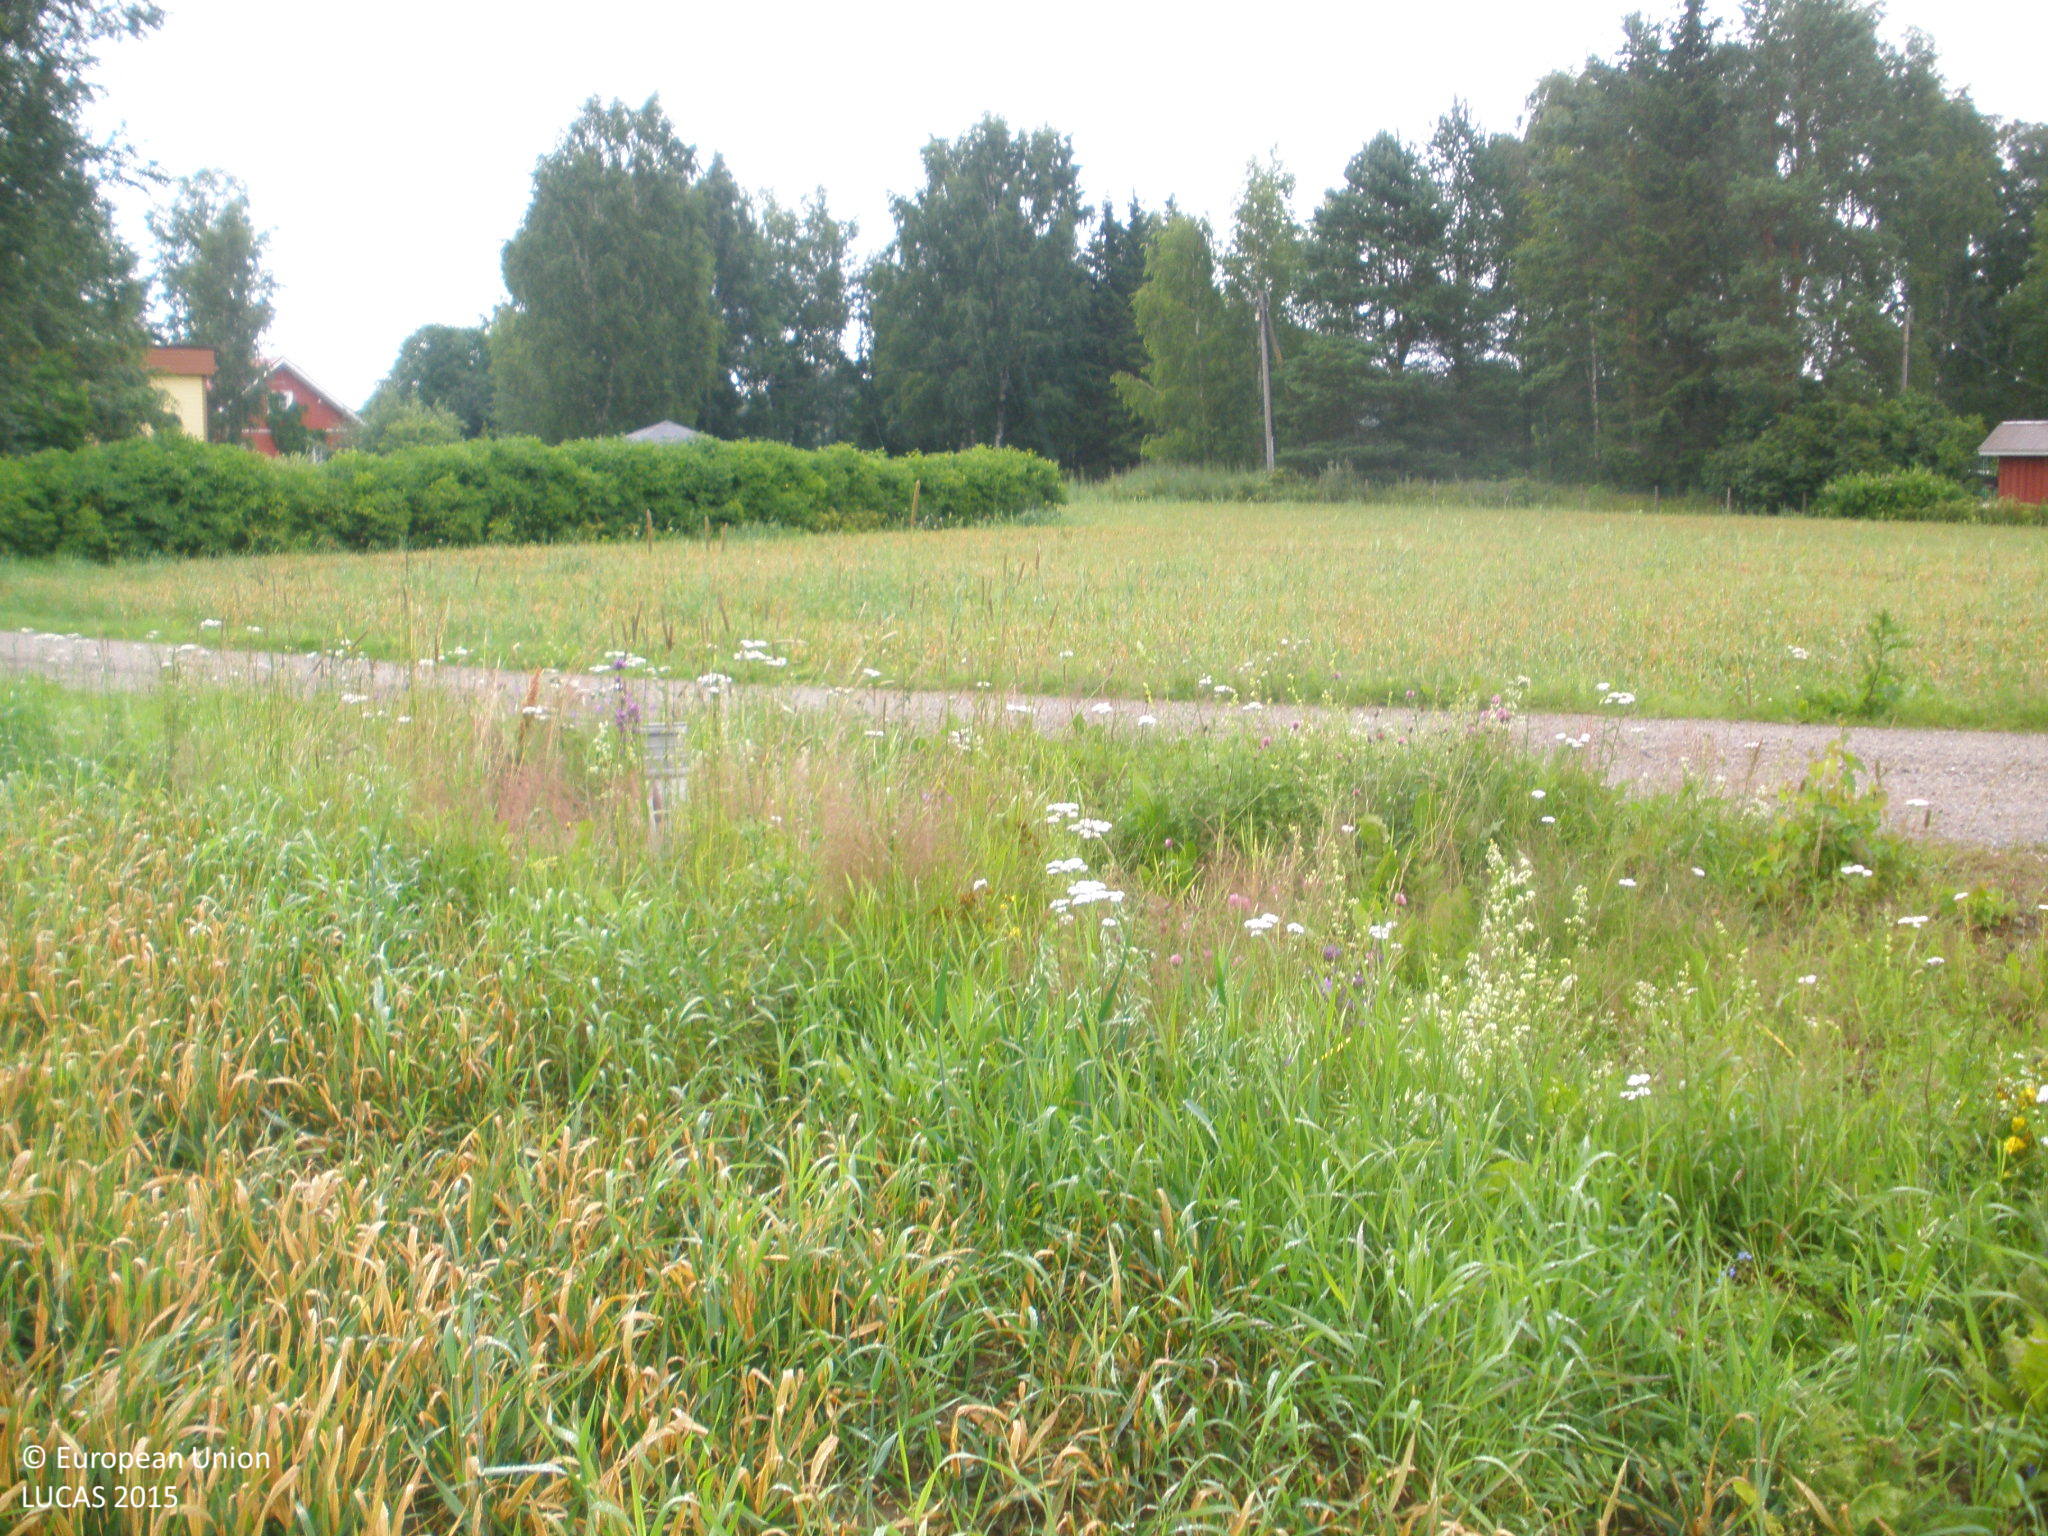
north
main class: Cropland
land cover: Barley
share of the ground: 25 - 50 %
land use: Agriculture (excluding fallow land and kitchen gardens)
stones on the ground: < 10 %
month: July
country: FI
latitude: 61.1606
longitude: 24.7705
